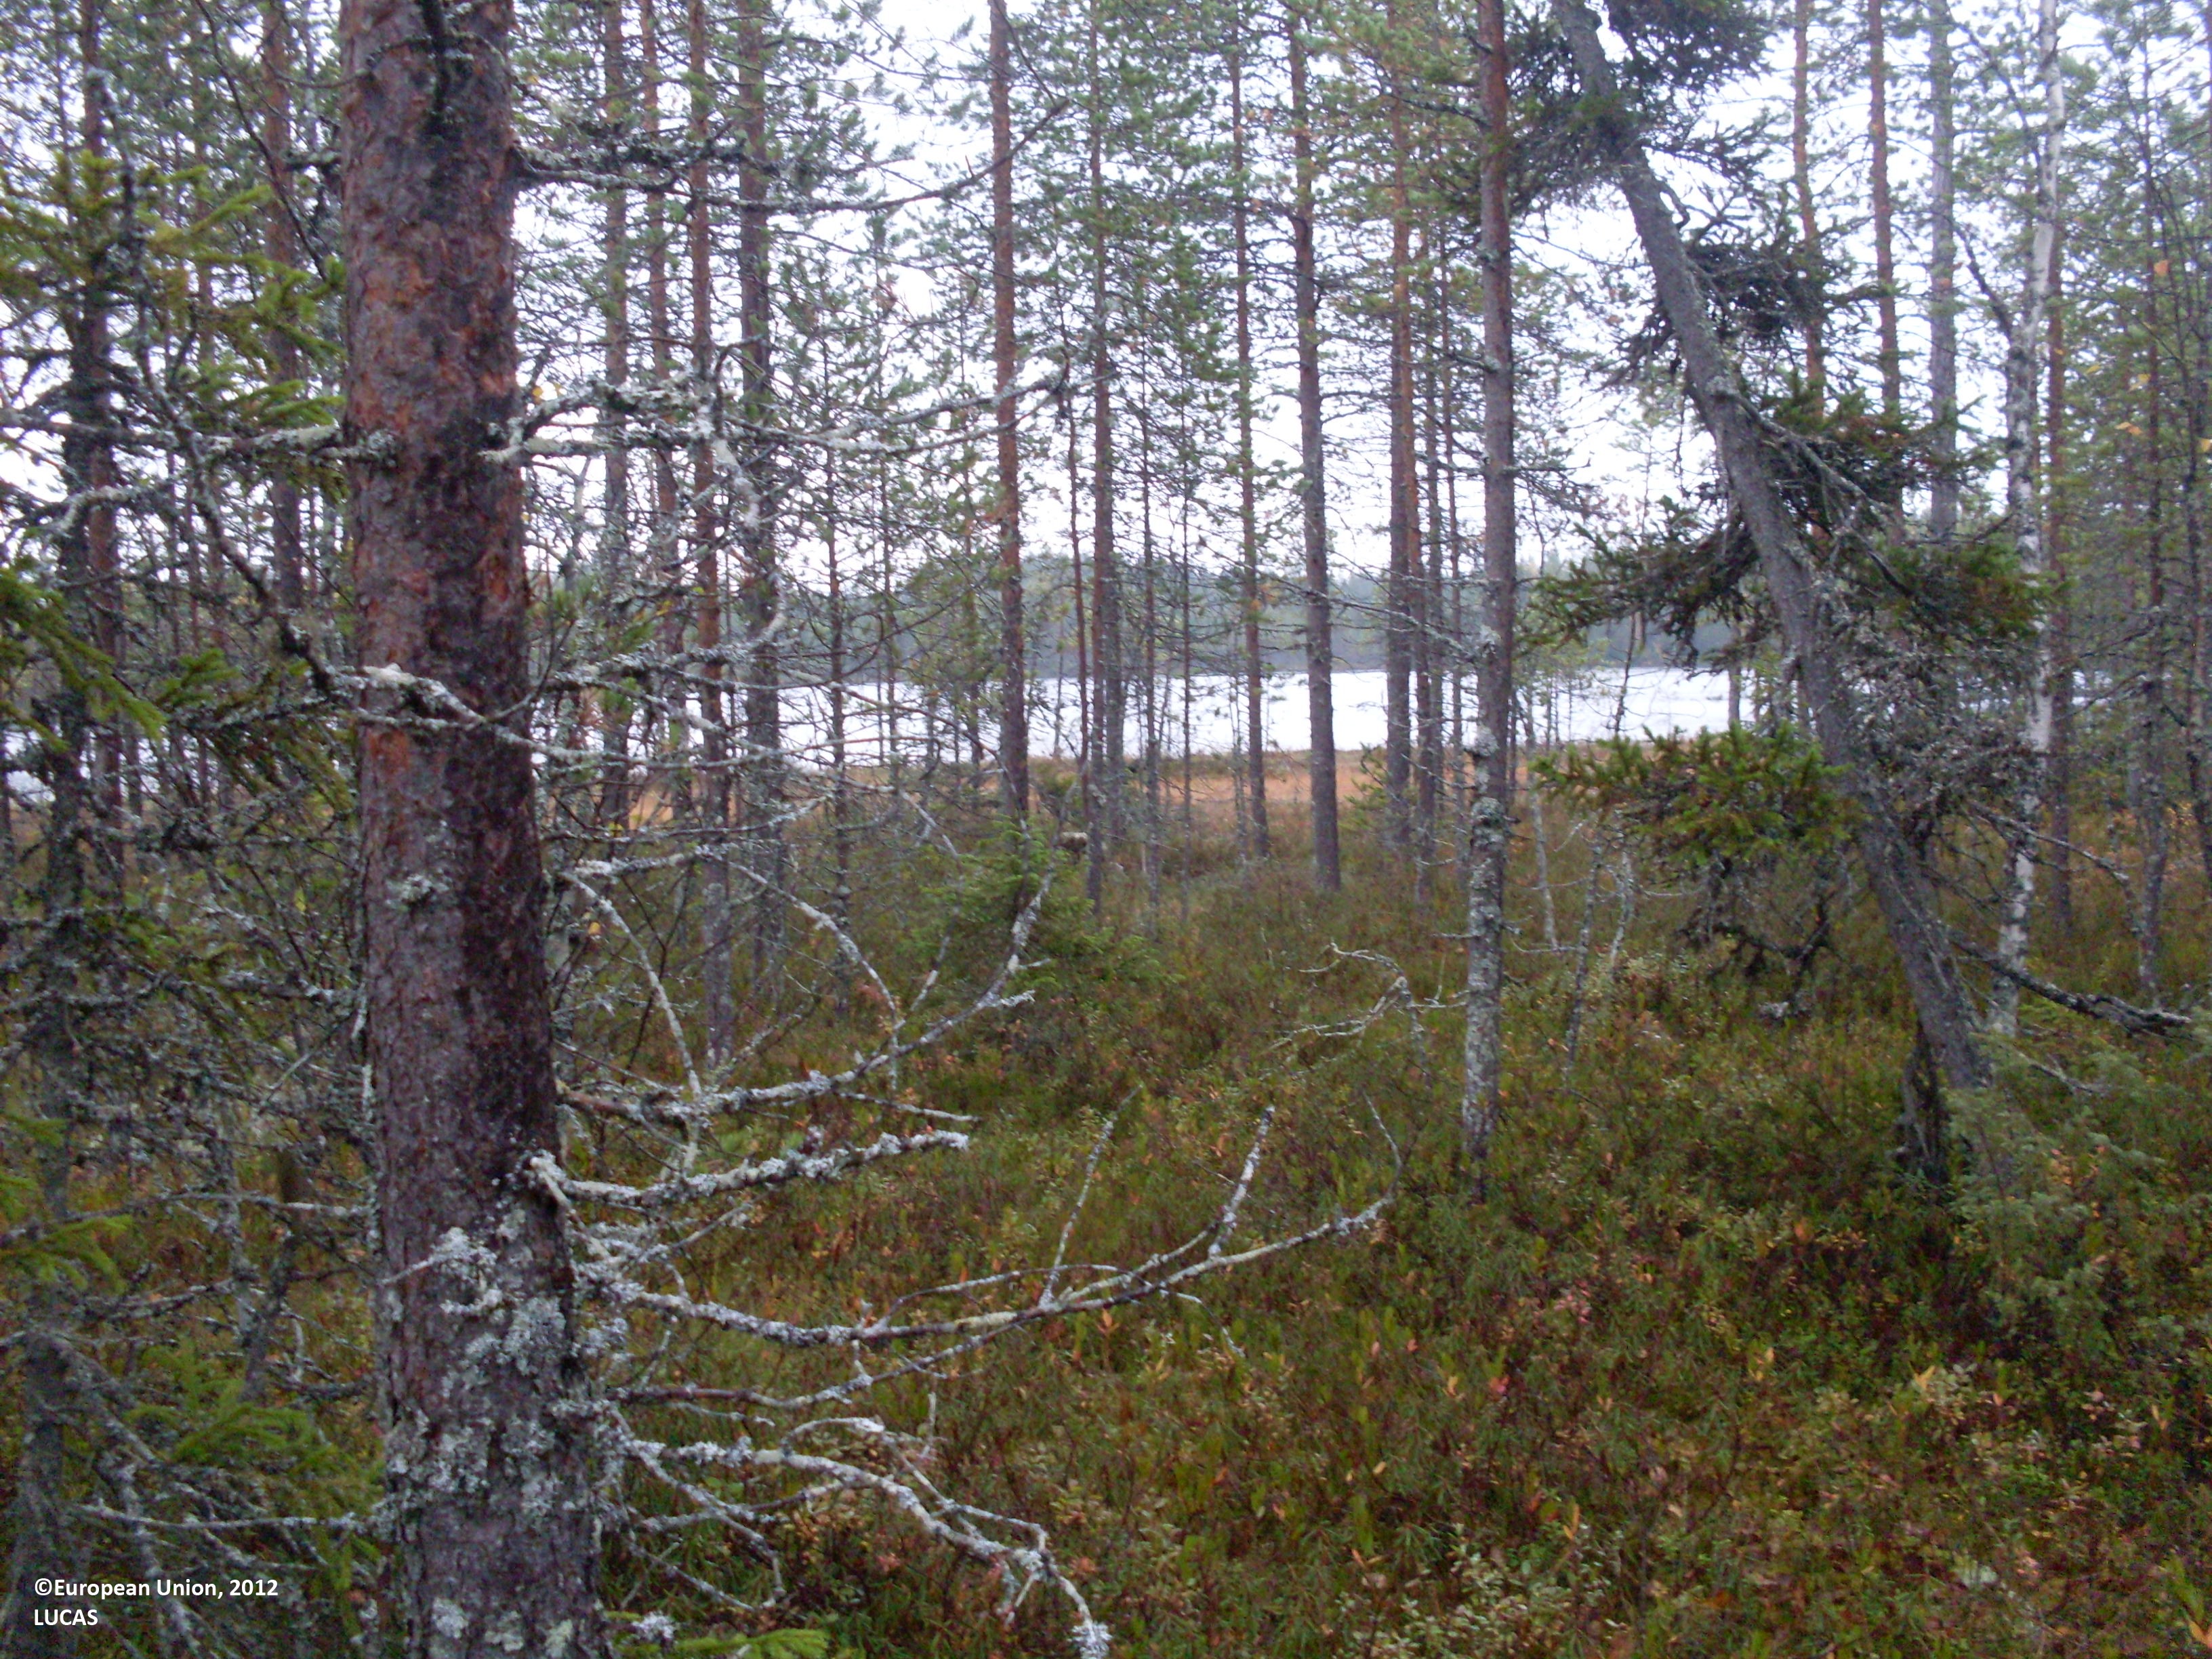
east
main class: Woodland
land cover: Pine dominated coniferous woodland
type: boreal forest
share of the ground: 50 - 75 %
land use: Forestry
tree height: > 5 m
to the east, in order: Pine dominated coniferous woodland; Pine dominated mixed woodland; Inland marshes; Inland water bodies
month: September
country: FI
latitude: 64.3990
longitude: 29.0951
